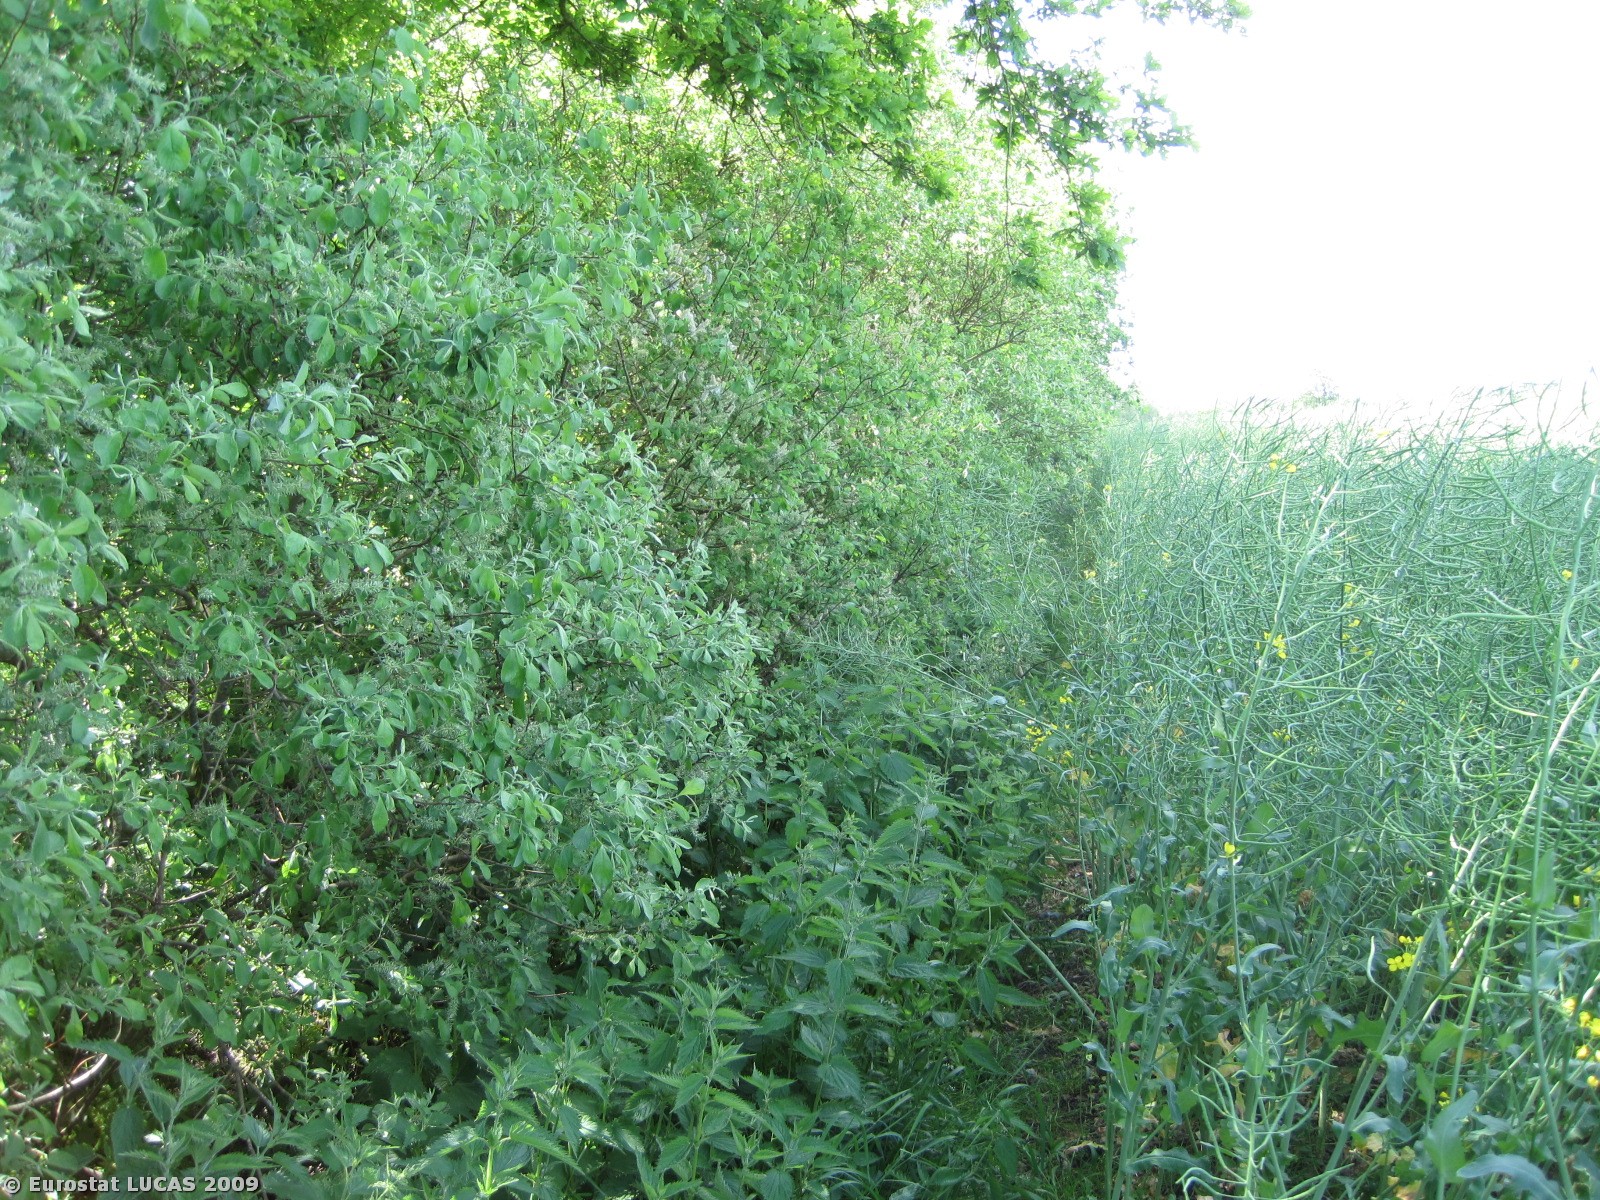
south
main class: Cropland
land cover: Rape and turnip rape
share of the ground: > 75 %
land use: Agriculture (excluding fallow land and kitchen gardens)
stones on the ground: < 10 %
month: June
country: DK
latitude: 56.9426
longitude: 10.2134
